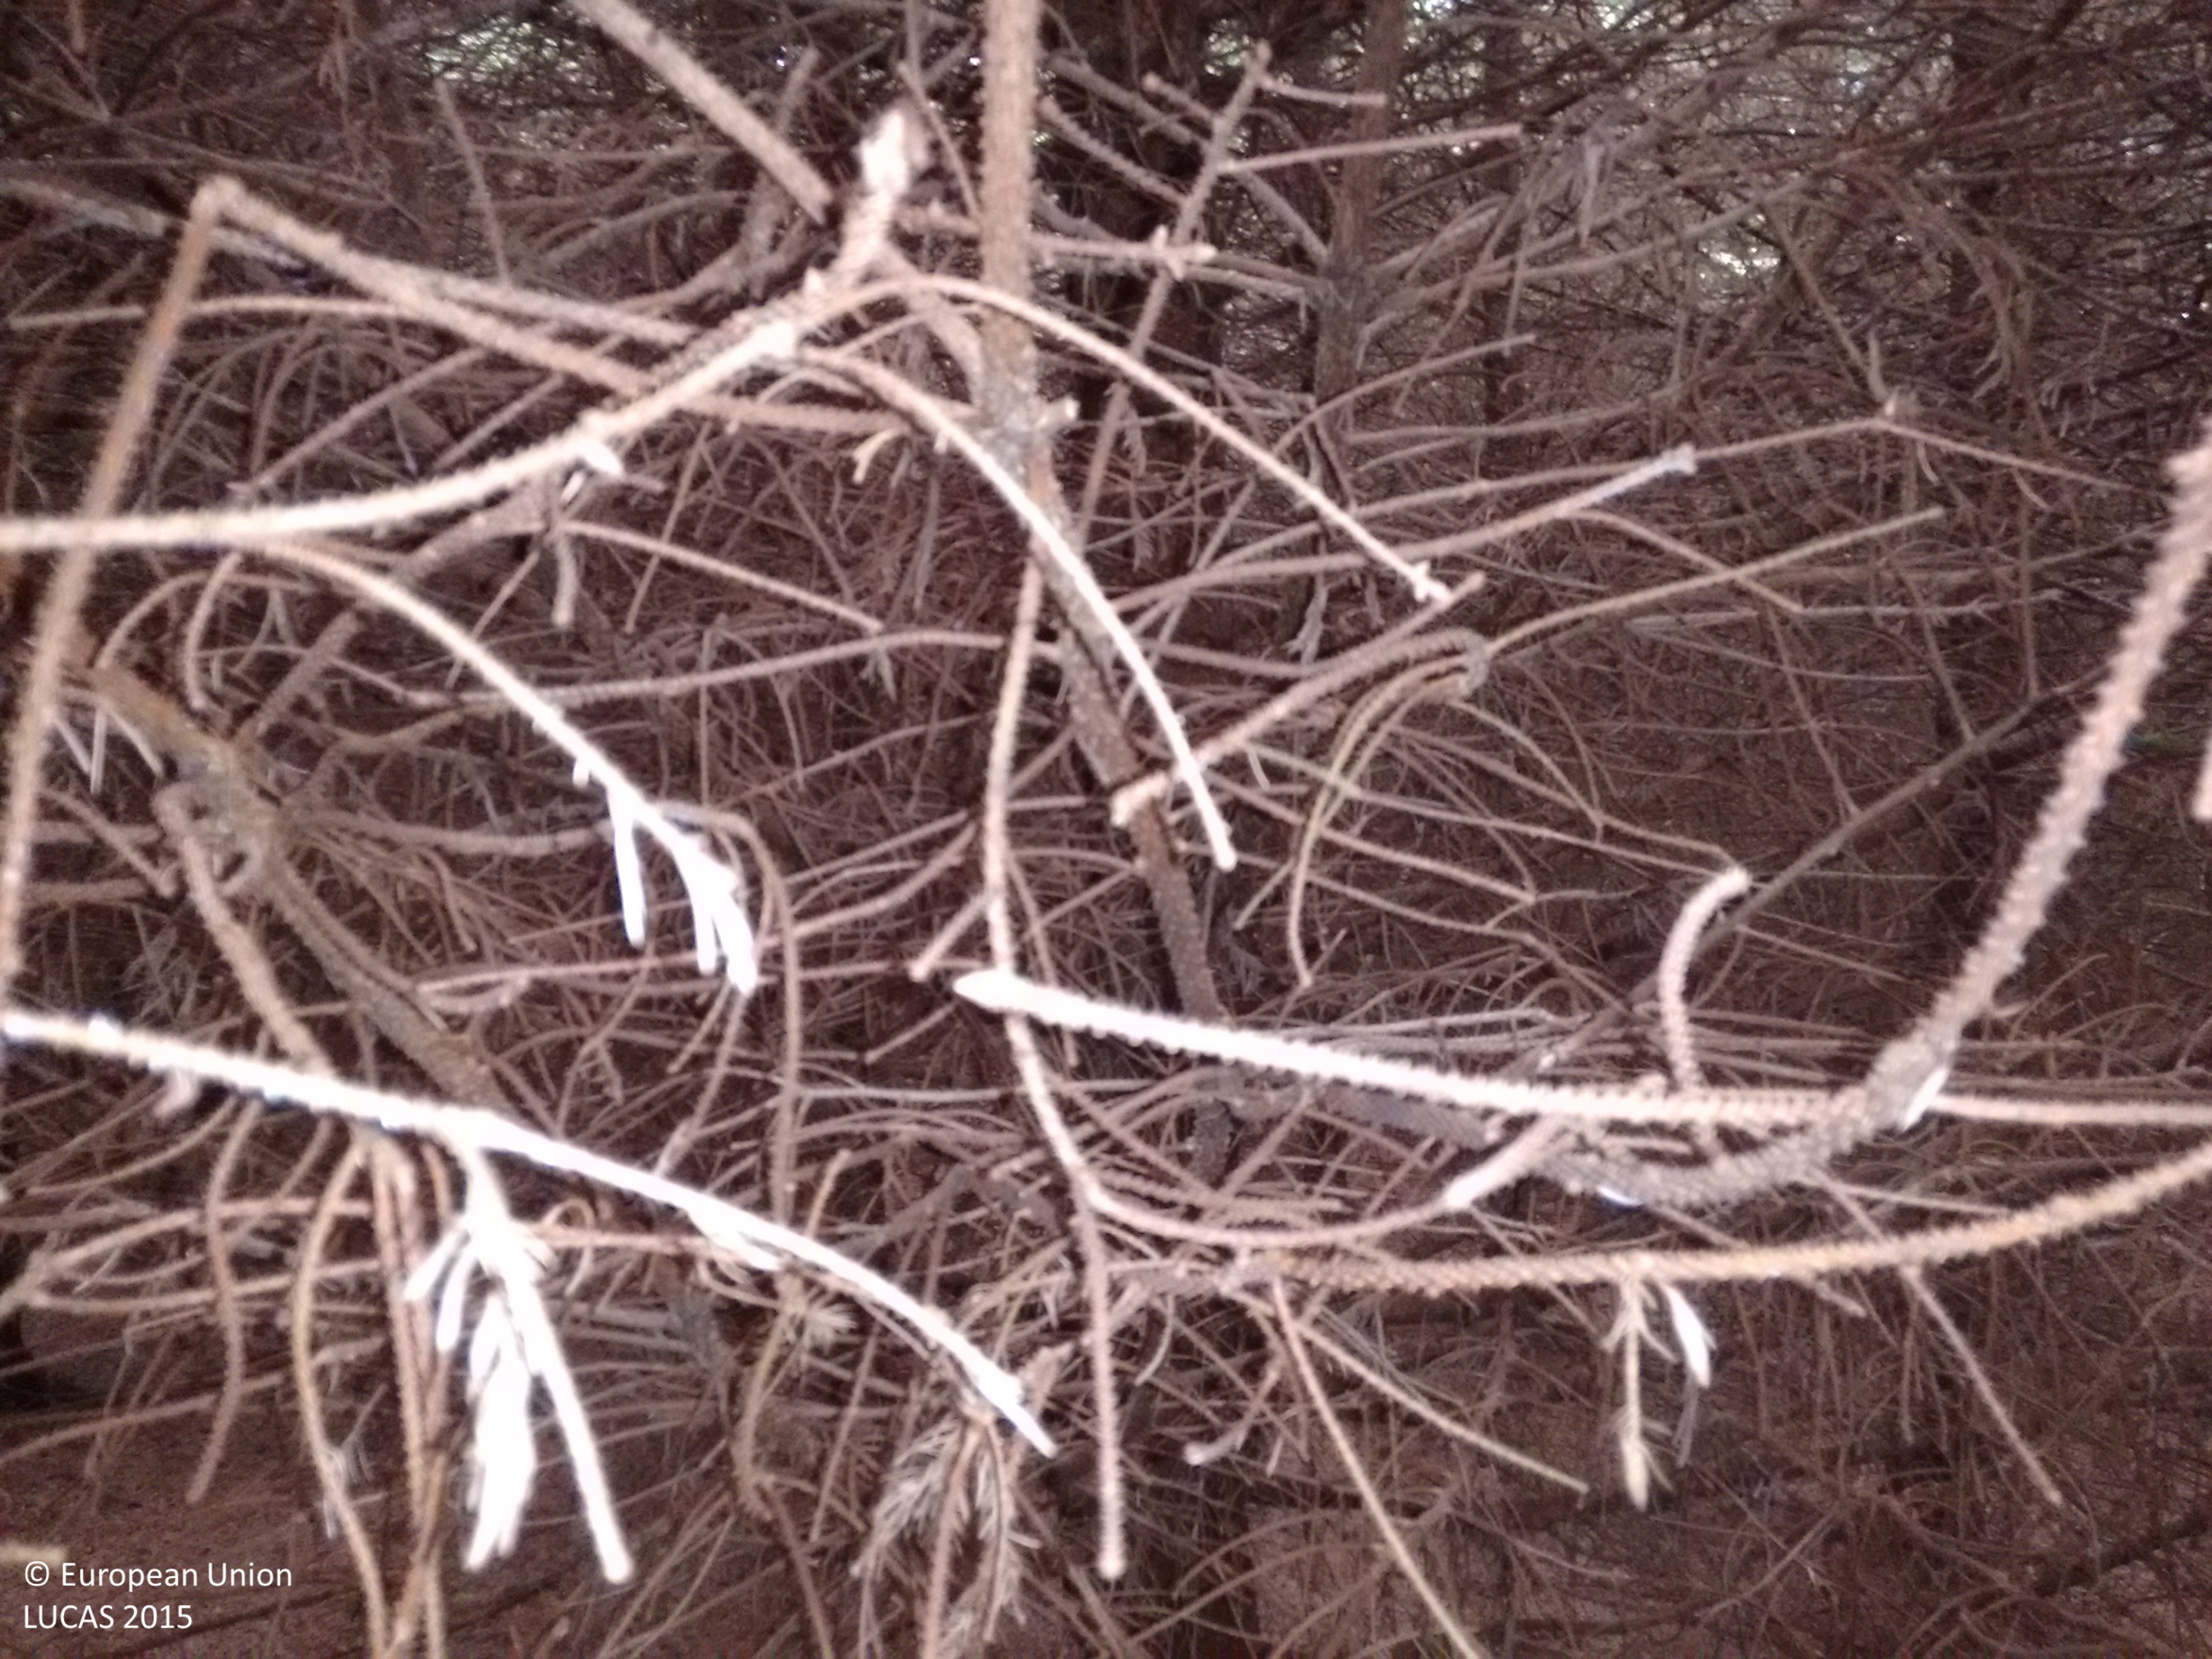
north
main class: Woodland
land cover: Spruce dominated coniferous woodland
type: exotic forest
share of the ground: > 75 %
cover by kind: coniferous forest trees 100 %
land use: Forestry
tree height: > 5 m
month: June
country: IE
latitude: 52.0310
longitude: -8.0327
